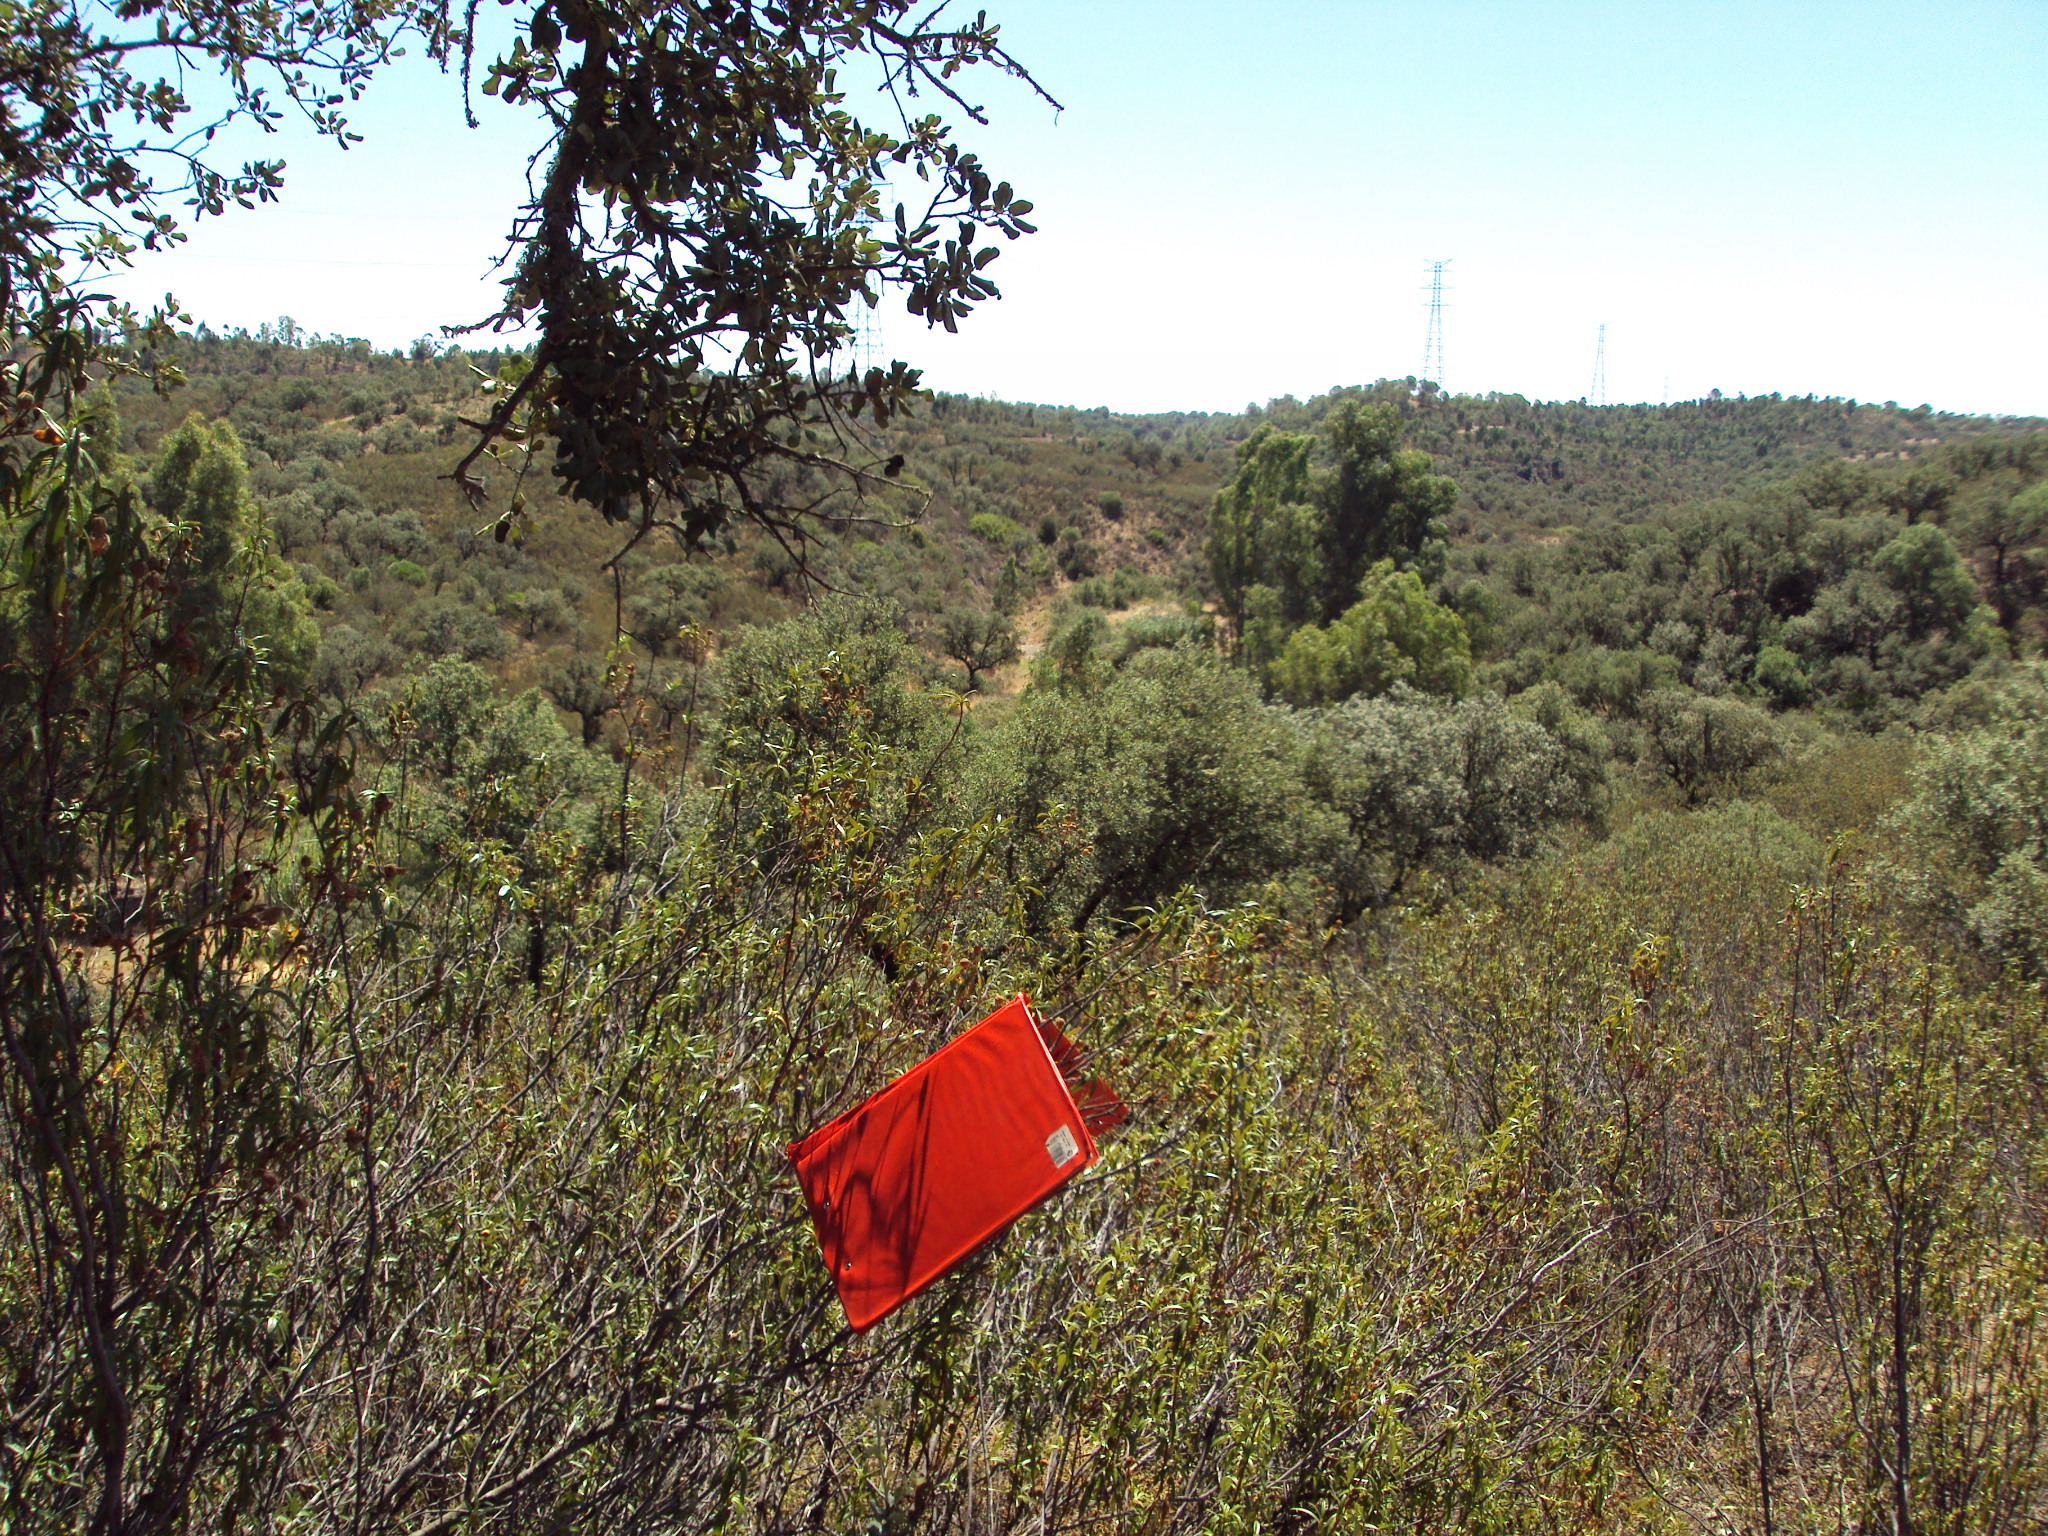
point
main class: Woodland
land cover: Broadleaved woodland
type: broadleaved evergreen forest
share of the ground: 10 - 25 %
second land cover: Spontaneously vegetated surfaces
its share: > 75 %
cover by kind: shrubs 80 %, broadleaved forest trees 20 %
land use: Forestry
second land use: Agriculture (excluding fallow land and kitchen gardens)
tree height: < 5 m
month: July
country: ES
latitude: 37.4507
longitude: -7.0569
